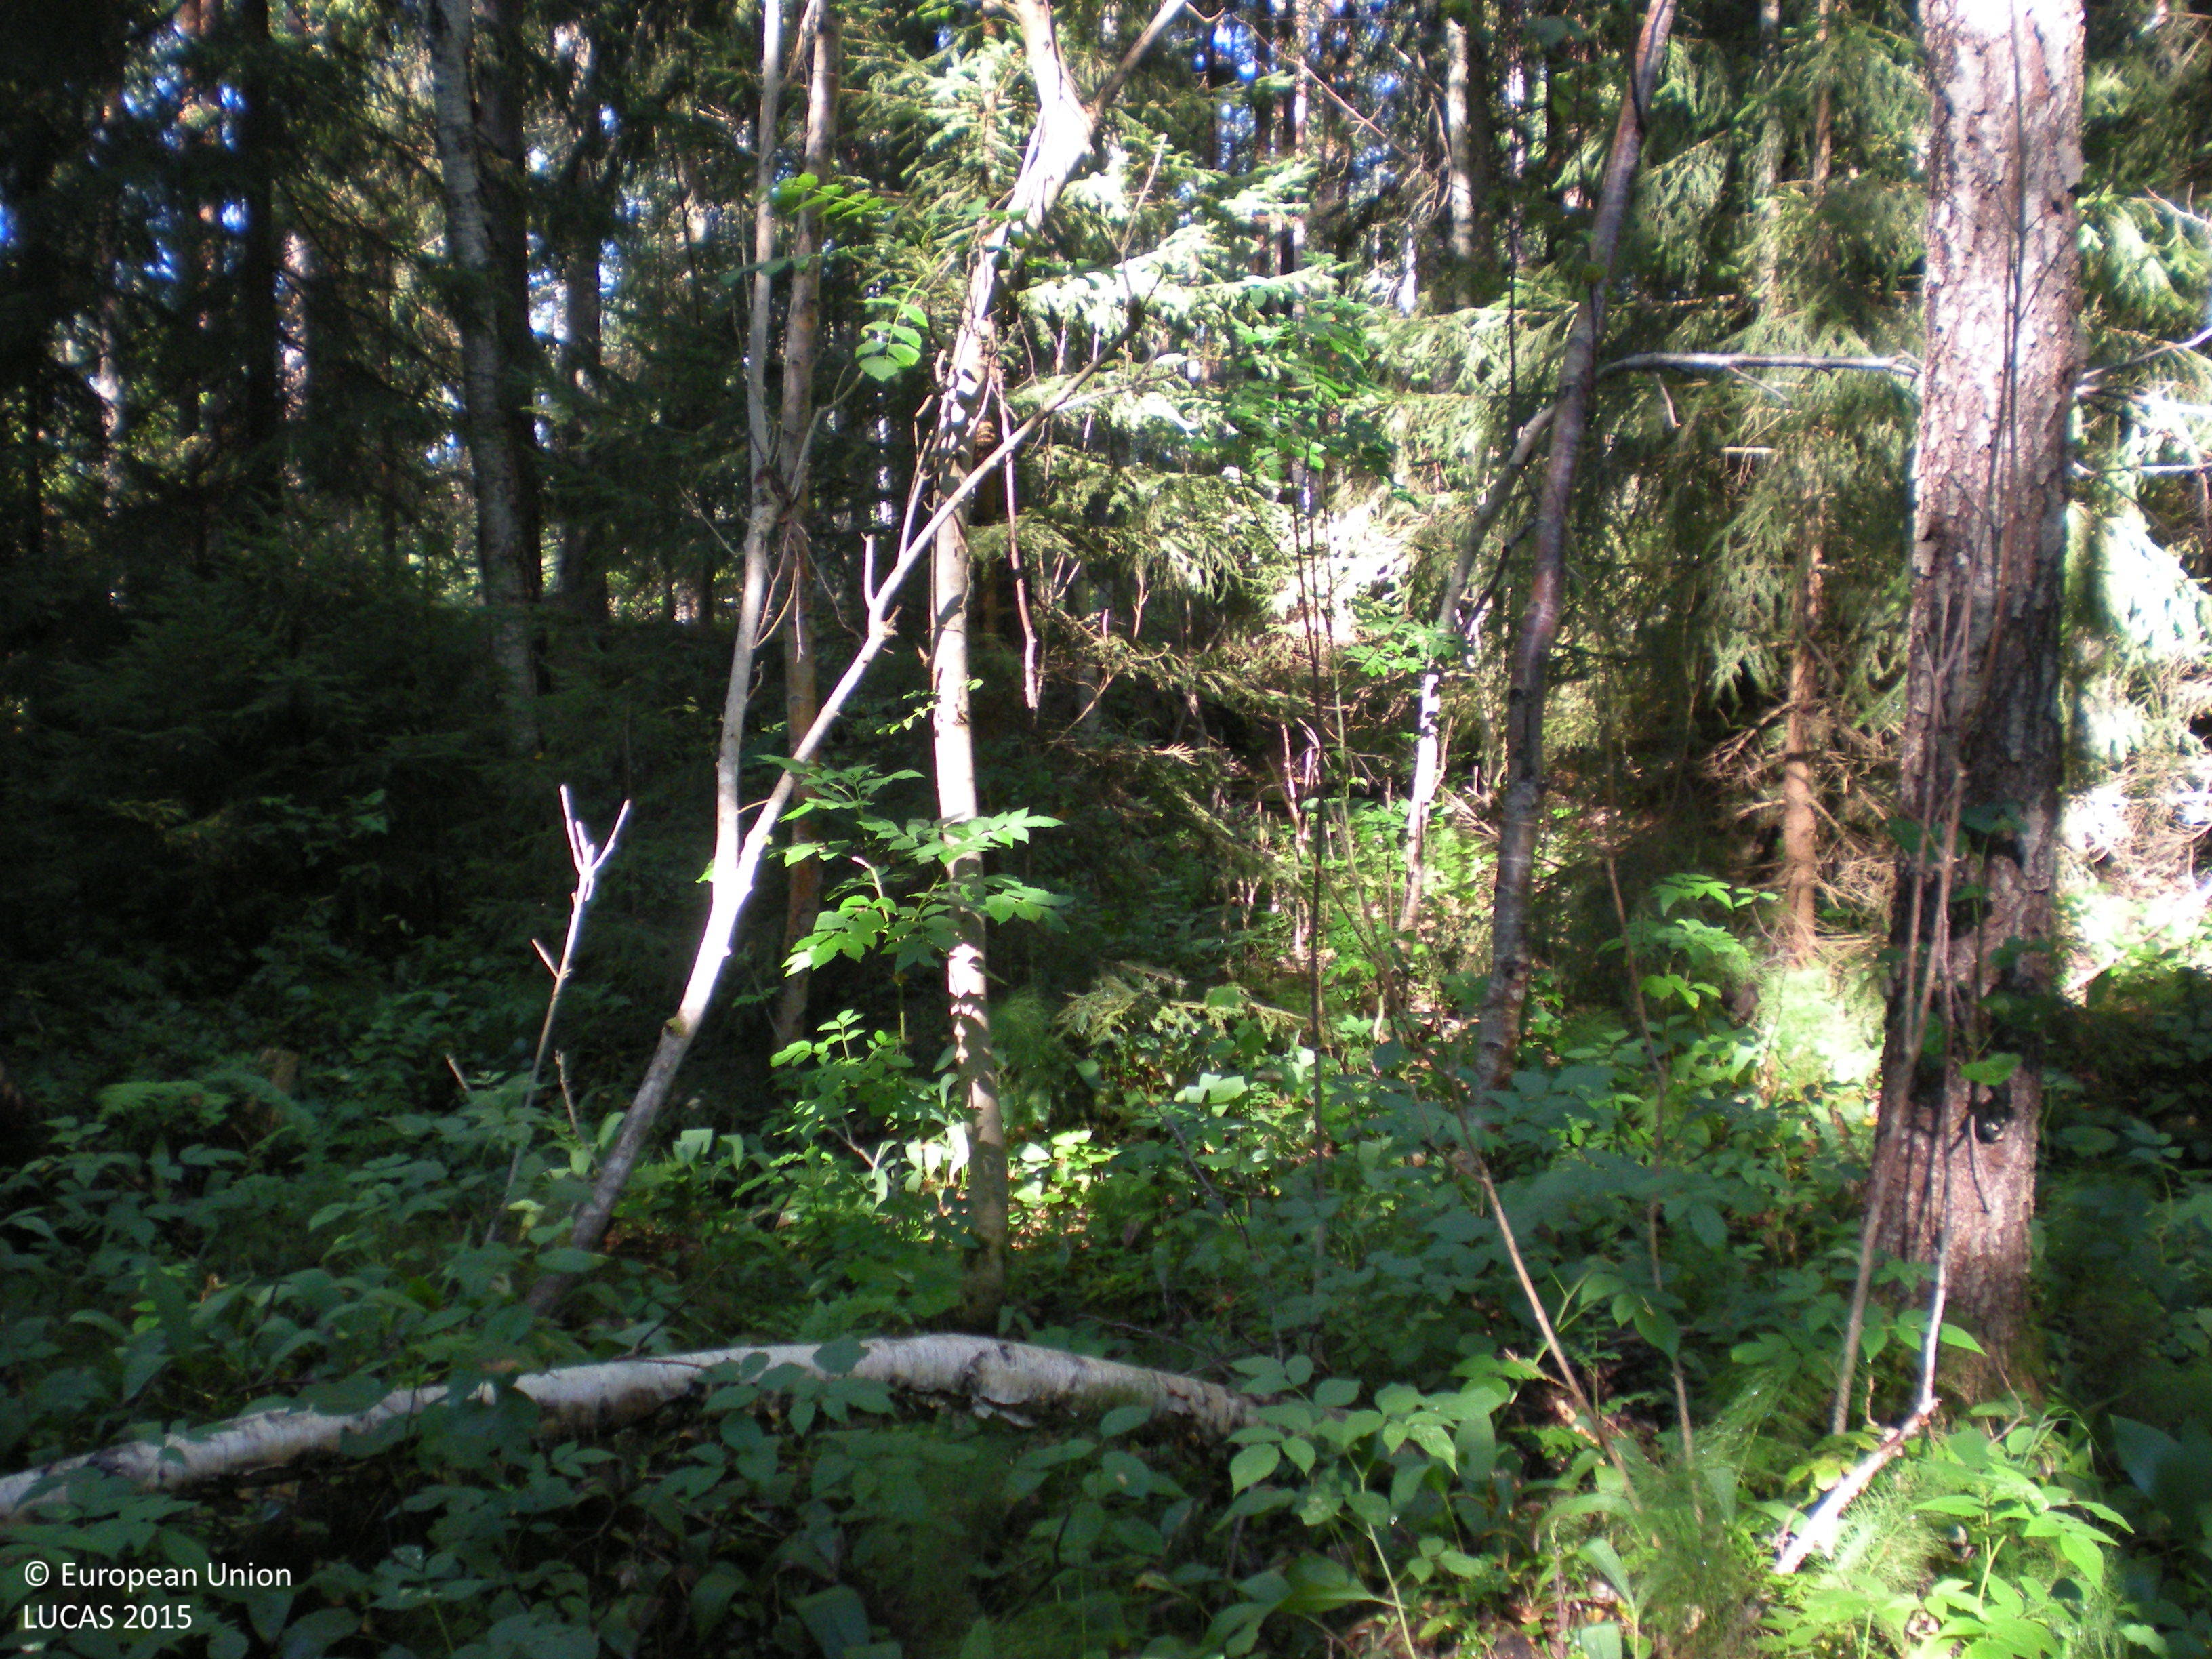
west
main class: Woodland
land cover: Broadleaved woodland
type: hemiboreal forest and nemoral coniferous forest and mixed broadleaved-coniferous forest
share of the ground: 50 - 75 %
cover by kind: broadleaved forest trees 65 %, herbaceous plants 25 %, coniferous forest trees 5 %
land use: Forestry
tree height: > 5 m
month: August
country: SE
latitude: 60.7546
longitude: 17.2370
